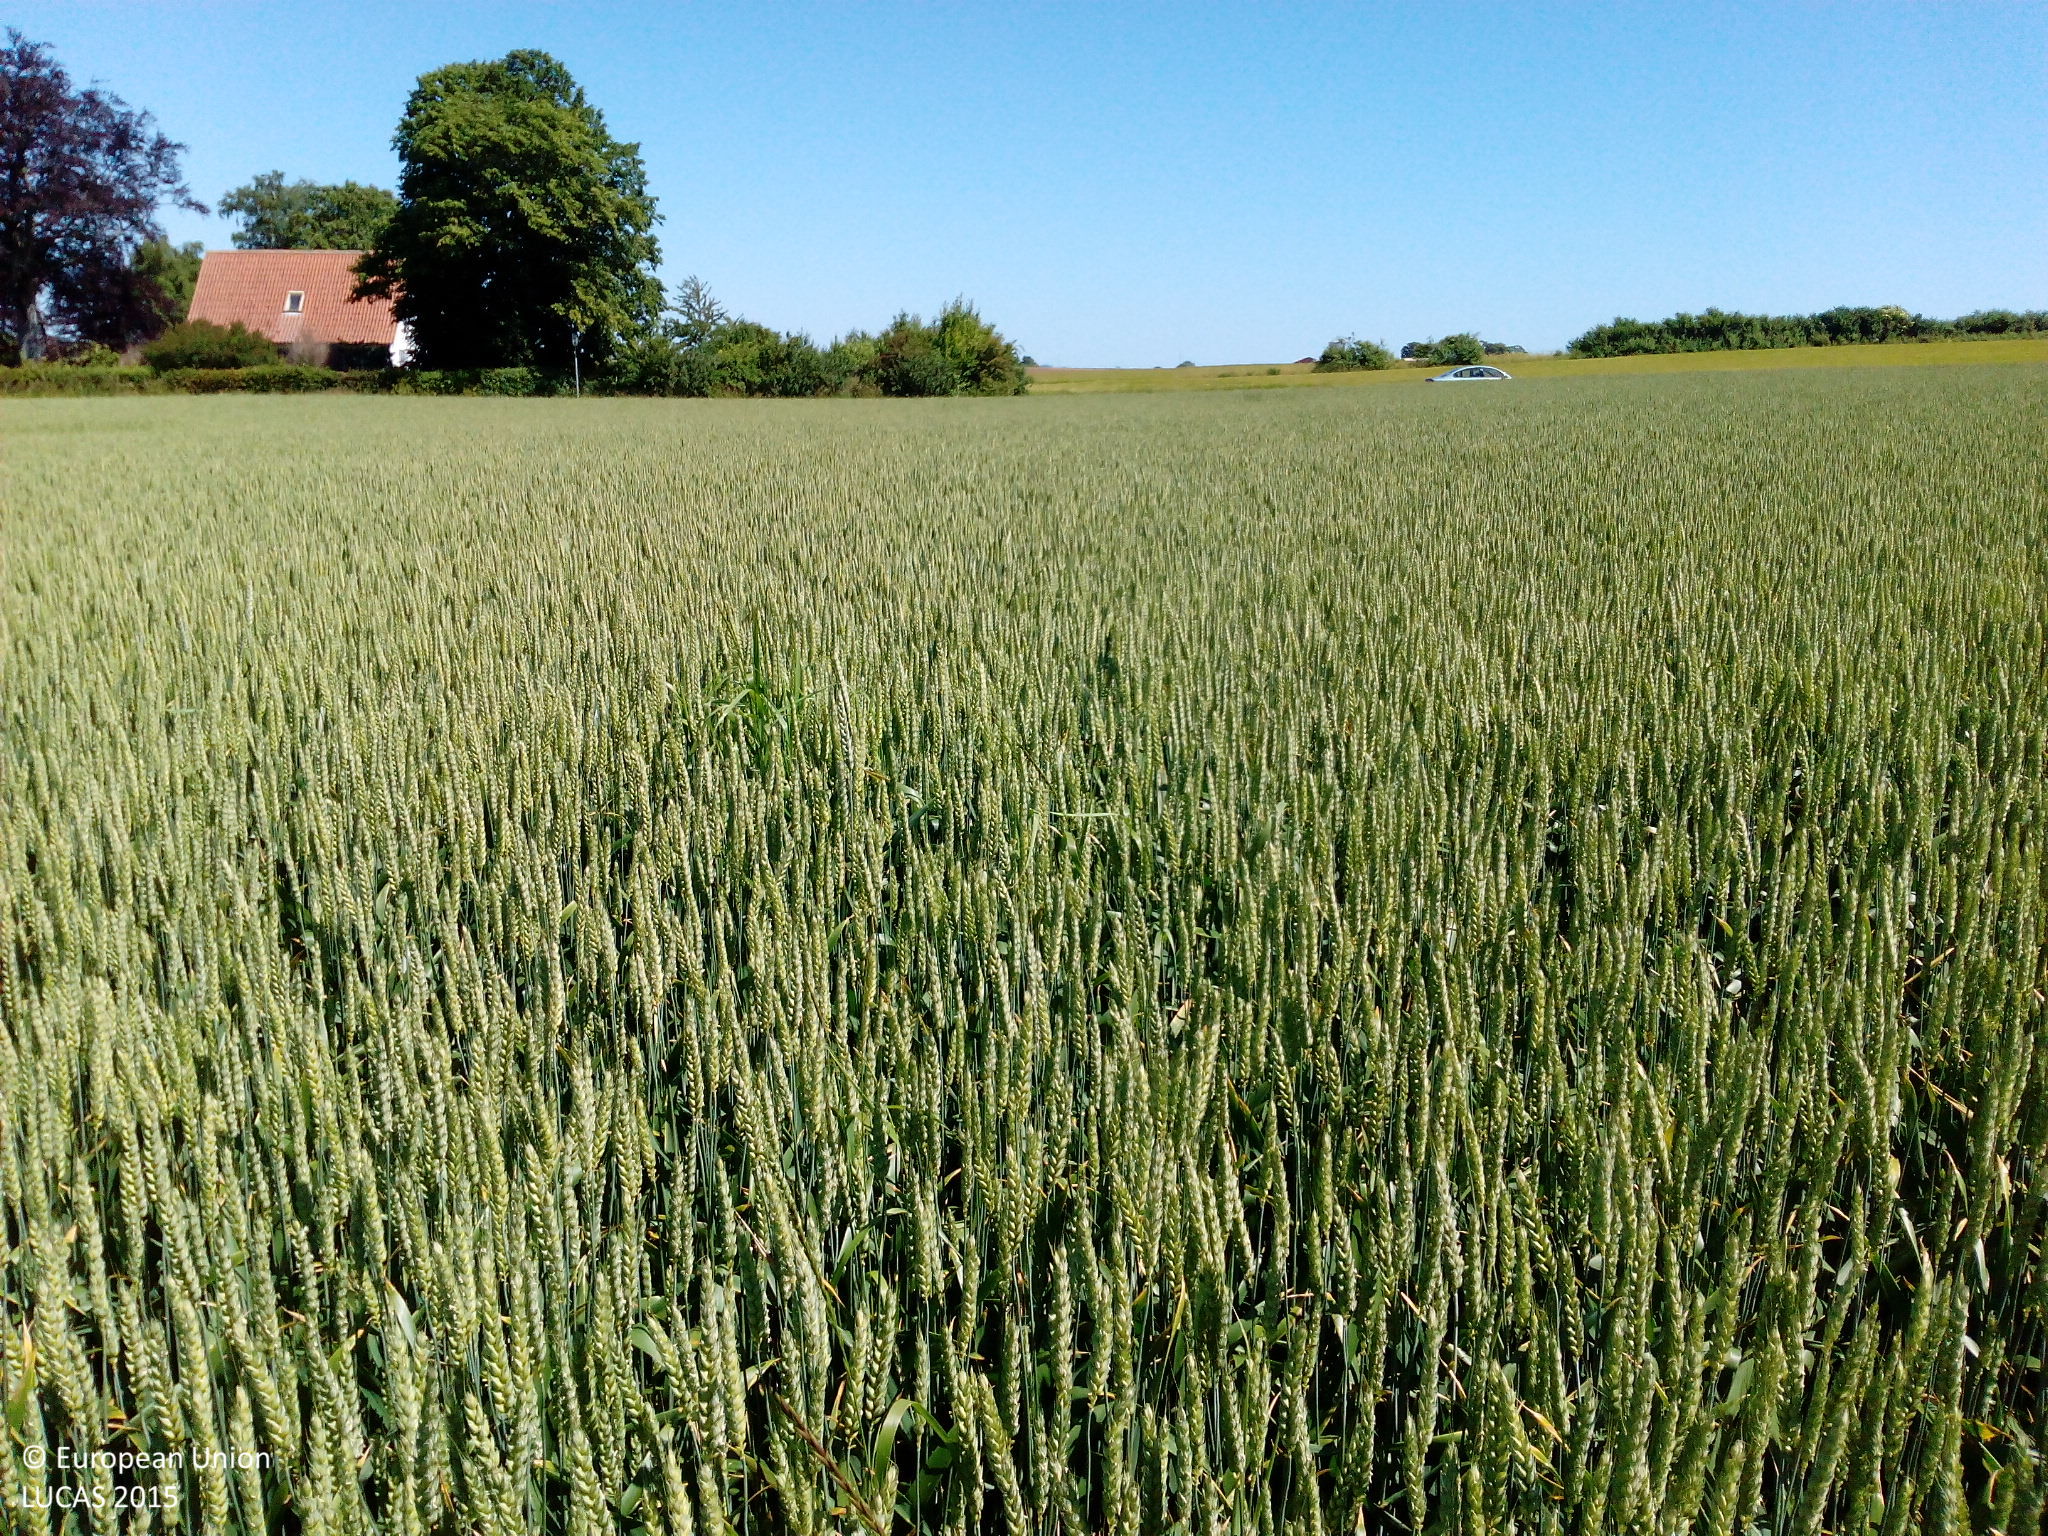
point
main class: Cropland
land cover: Common wheat
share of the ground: > 75 %
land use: Agriculture (excluding fallow land and kitchen gardens)
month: July
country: DK
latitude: 54.9625
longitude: 12.2945
